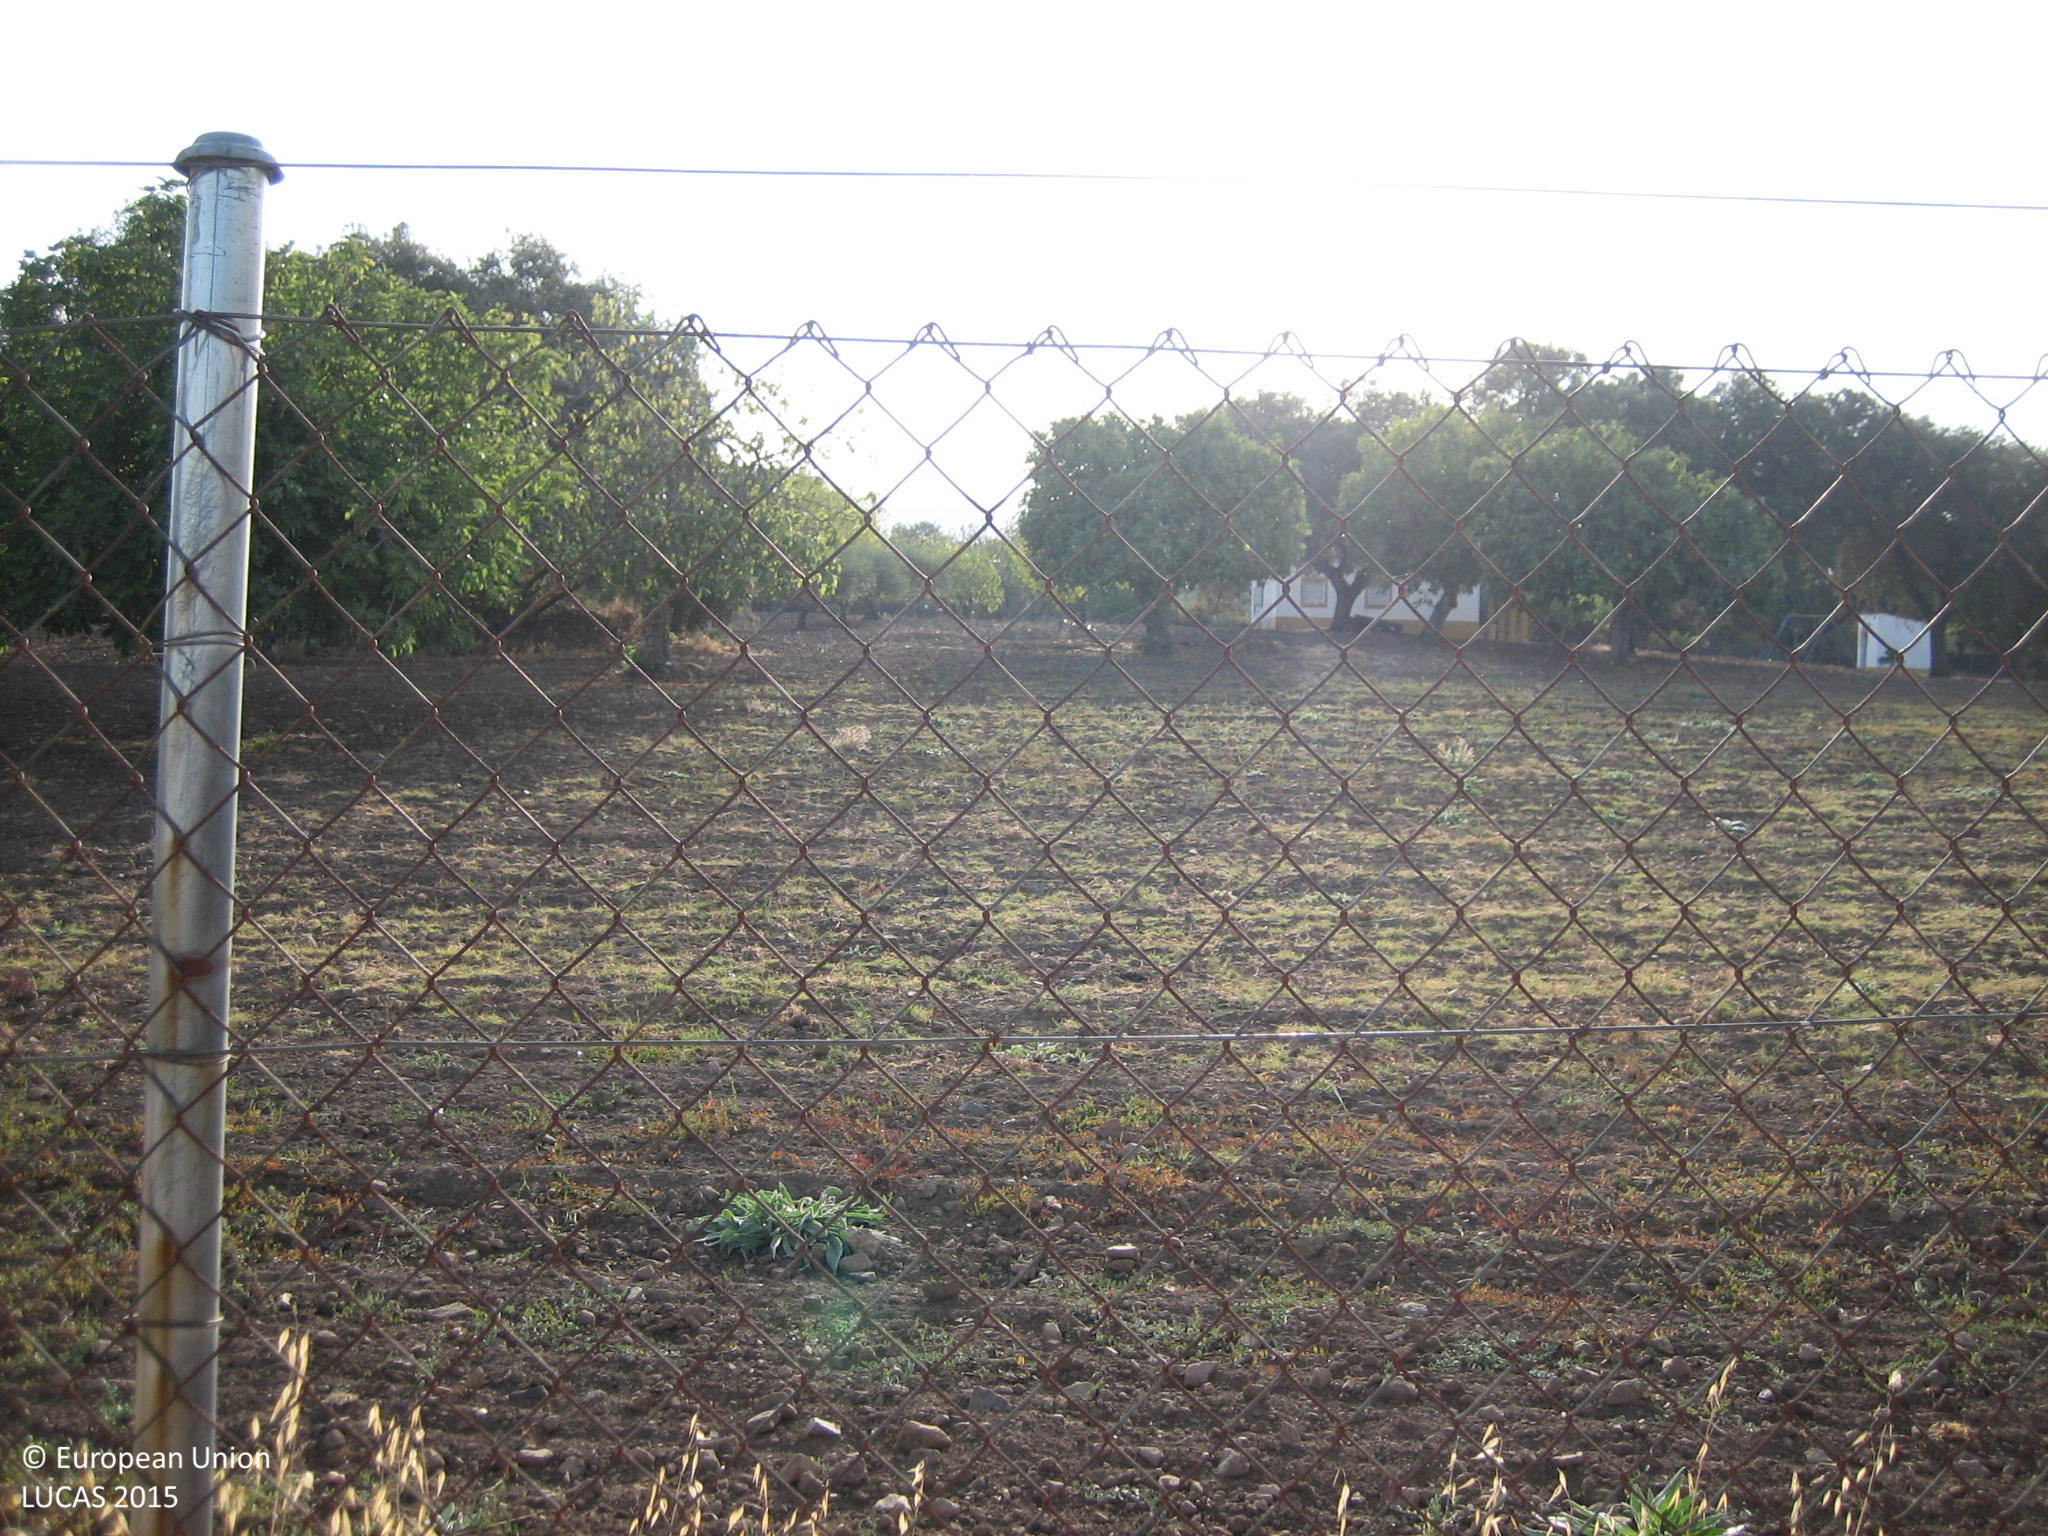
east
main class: Grassland
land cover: Grassland without tree/shrub cover
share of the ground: > 75 %
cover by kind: herbaceous plants 100 %
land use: Semi-natural and natural areas not in use
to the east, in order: Grassland without tree/shrub cover; Fences; Electric lines; Other fruit trees and berries; Olive groves; Lines of trees; Fences; Other fruit trees and berries; Fences; Olive groves; Lines of trees; Fences; Other fruit trees and berries
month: September
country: ES
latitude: 38.4837
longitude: -6.8546
